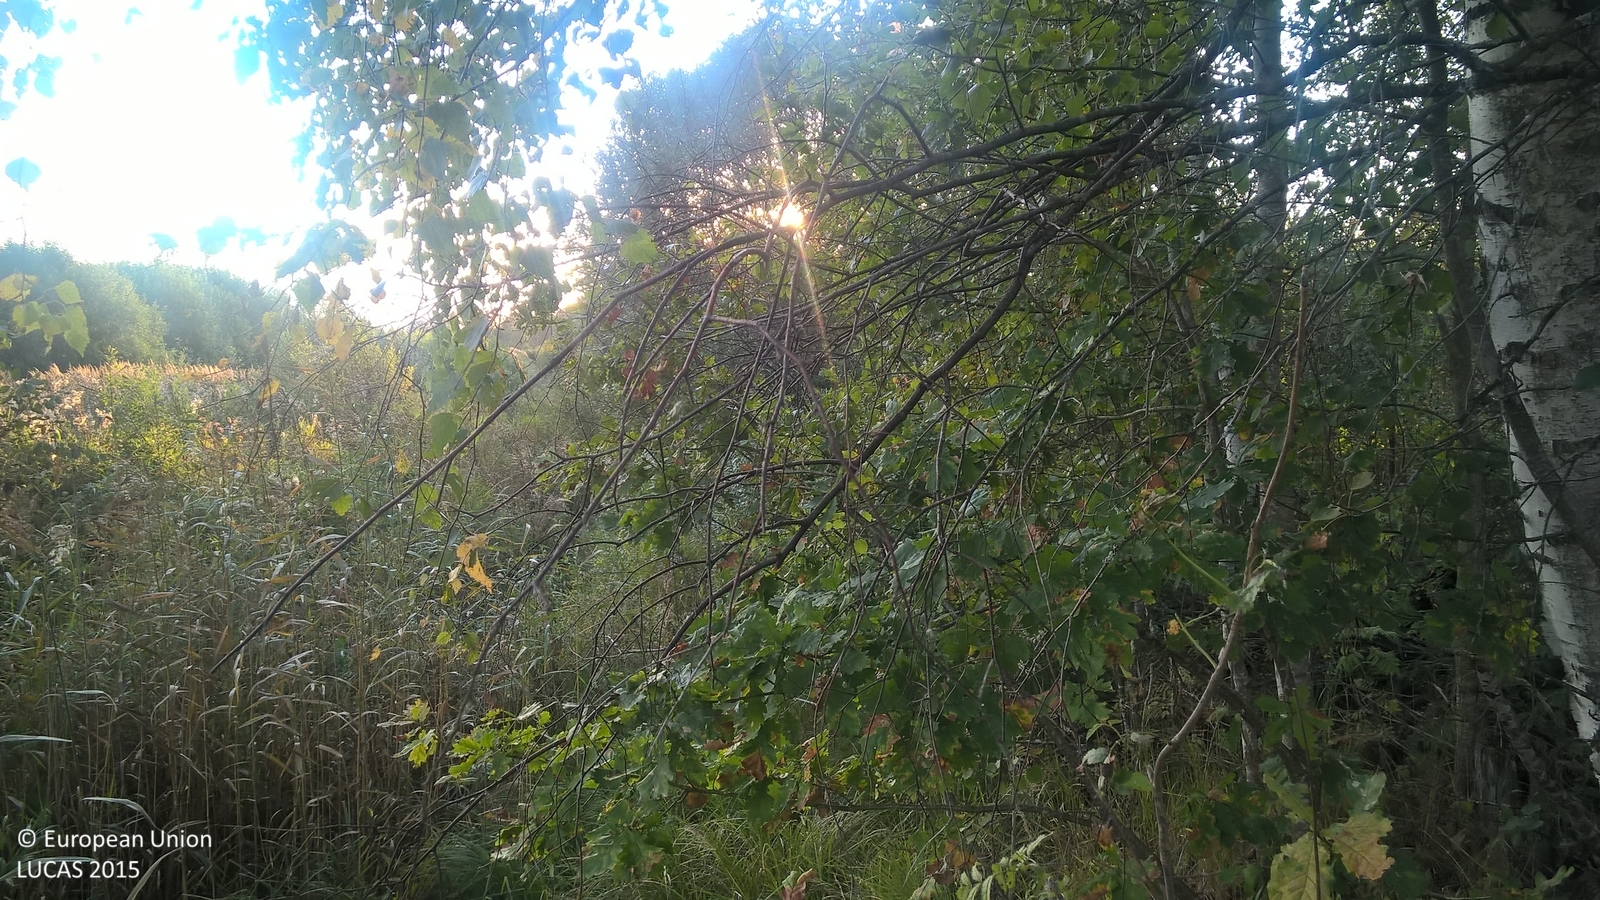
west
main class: Woodland
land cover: Broadleaved woodland
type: non-riverine alder, birch or aspen forest
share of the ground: 50 - 75 %
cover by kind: broadleaved forest trees 60 %, lichens and mosses 30 %, shrubs 10 %
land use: Forestry
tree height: > 5 m
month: September
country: LV
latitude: 57.6745
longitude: 25.6960
